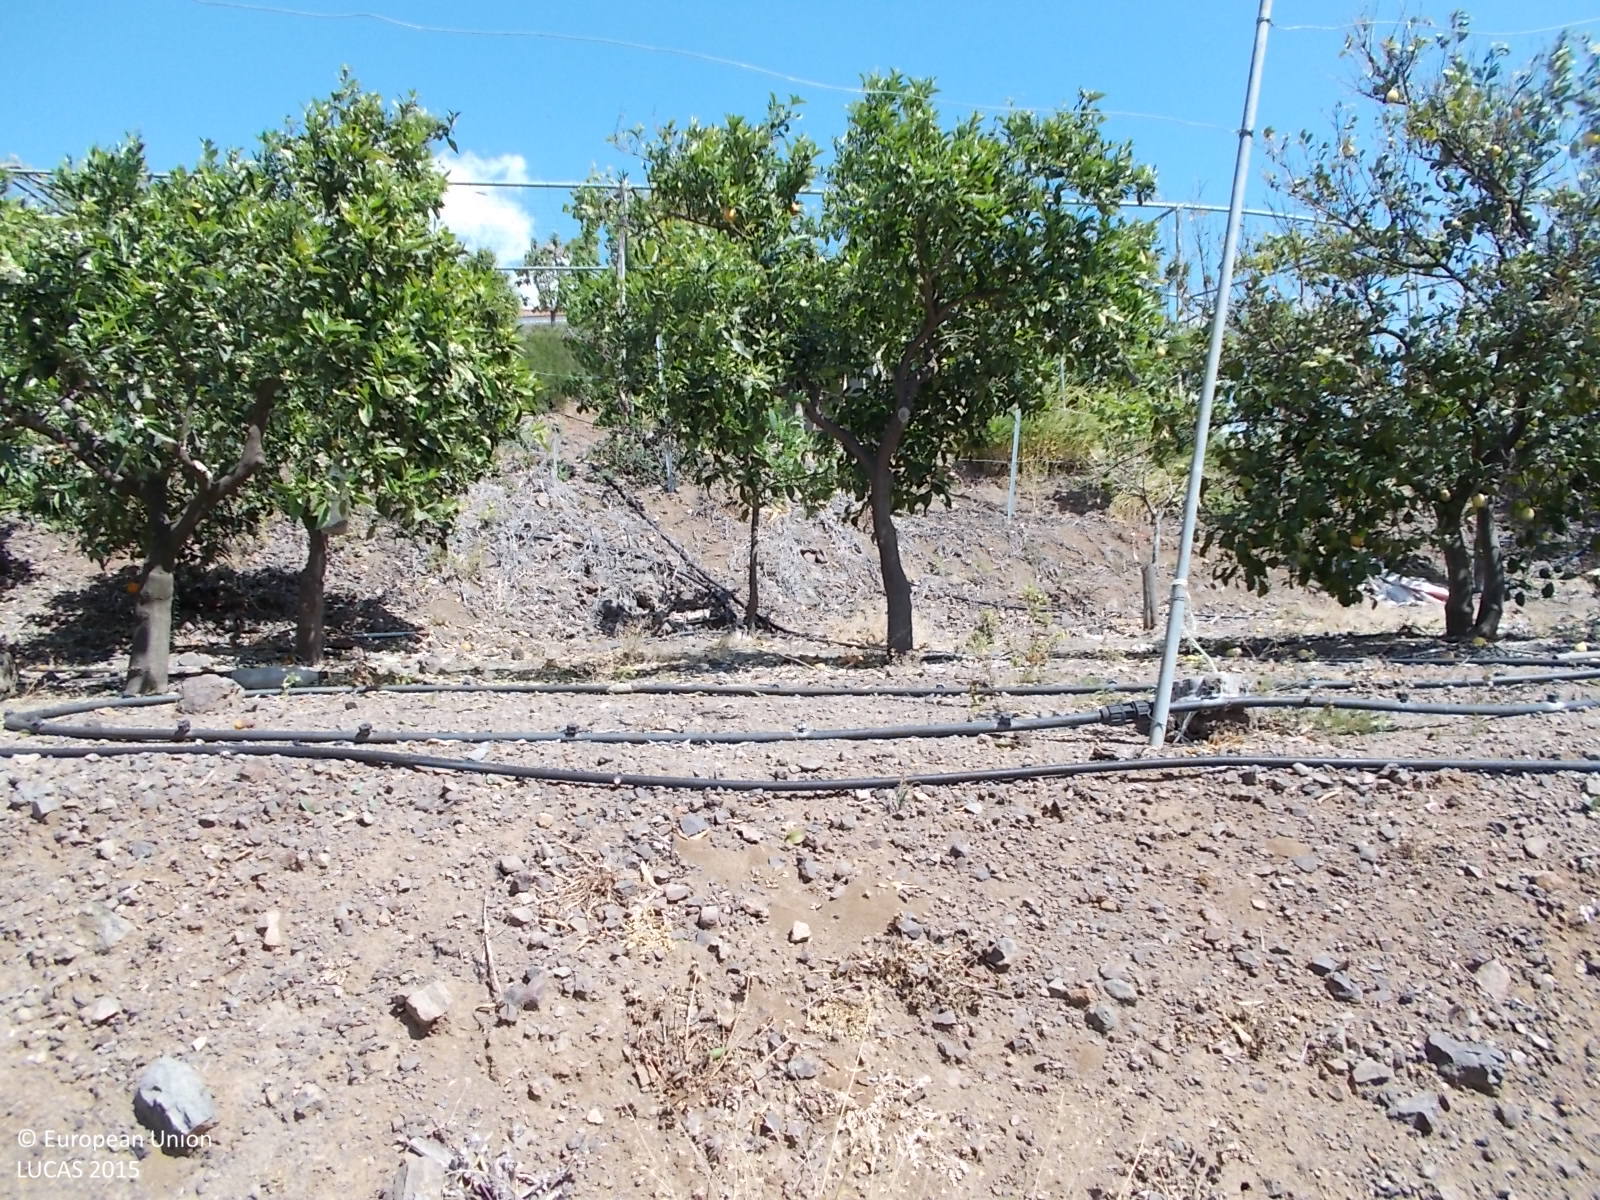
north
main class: Cropland
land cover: Other citrus fruit
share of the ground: > 75 %
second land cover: Other bare soil
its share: > 75 %
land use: Agriculture (excluding fallow land and kitchen gardens)
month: April
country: CY
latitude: 34.8475
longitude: 33.0840
